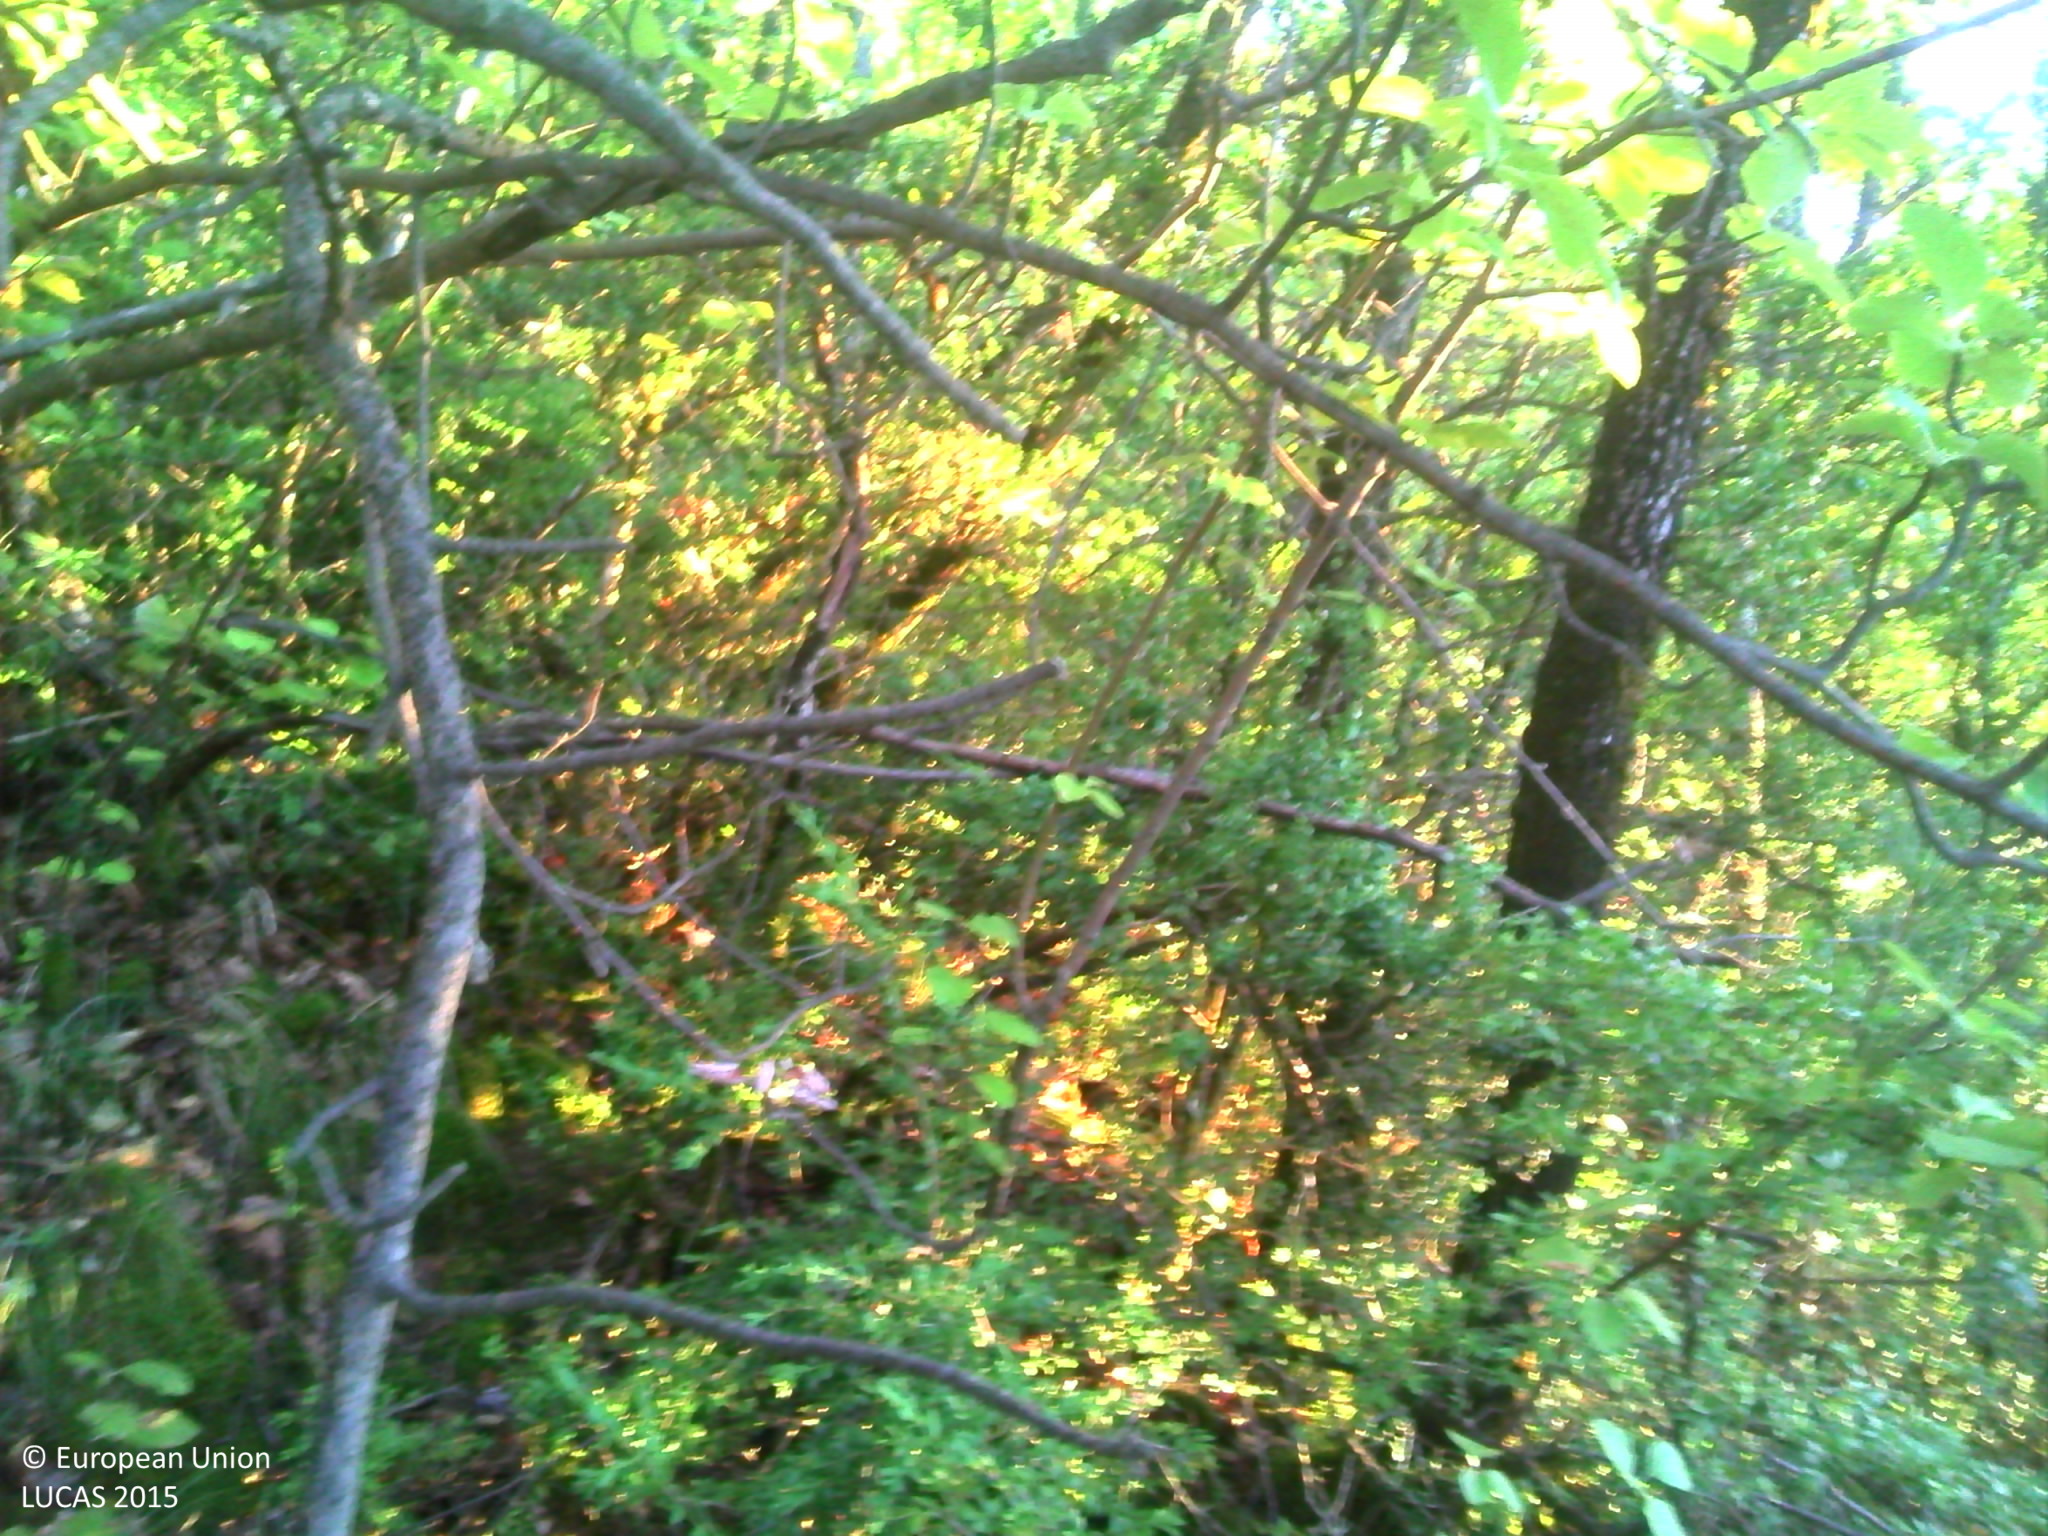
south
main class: Woodland
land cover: Broadleaved woodland
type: mesophytic deciduous forest
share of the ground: > 75 %
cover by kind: broadleaved forest trees 85 %, coniferous forest trees 5 %, shrubs 5 %, lichens and mosses 5 %
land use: Semi-natural and natural areas not in use
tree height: > 5 m
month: September
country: FR
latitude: 44.3457
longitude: 5.1529
